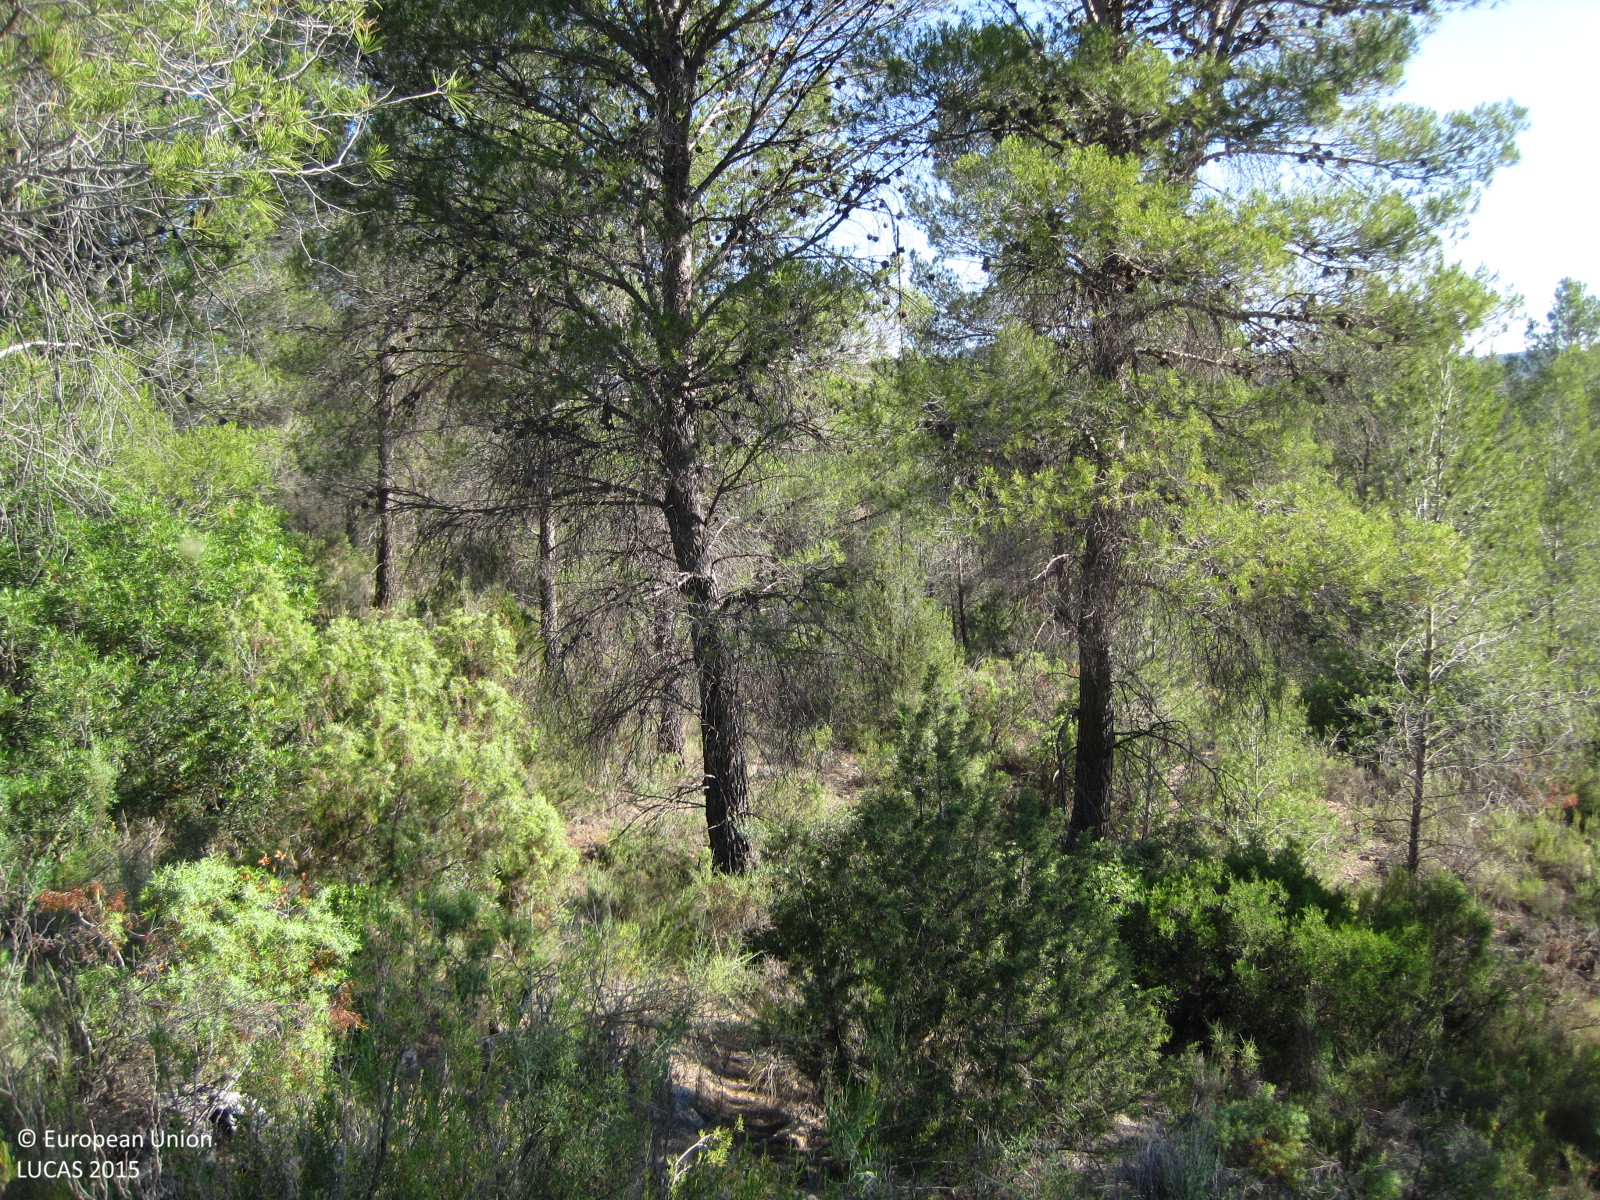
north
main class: Woodland
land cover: Pine dominated coniferous woodland
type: coniferous forest of the mediterranean region
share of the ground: 10 - 25 %
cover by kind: shrubs 40 %, coniferous forest trees 20 %, herbaceous plants 20 %, unconsolidated bare surface 20 %
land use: Semi-natural and natural areas not in use
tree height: > 5 m
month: June
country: ES
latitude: 39.2561
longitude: -1.0655
